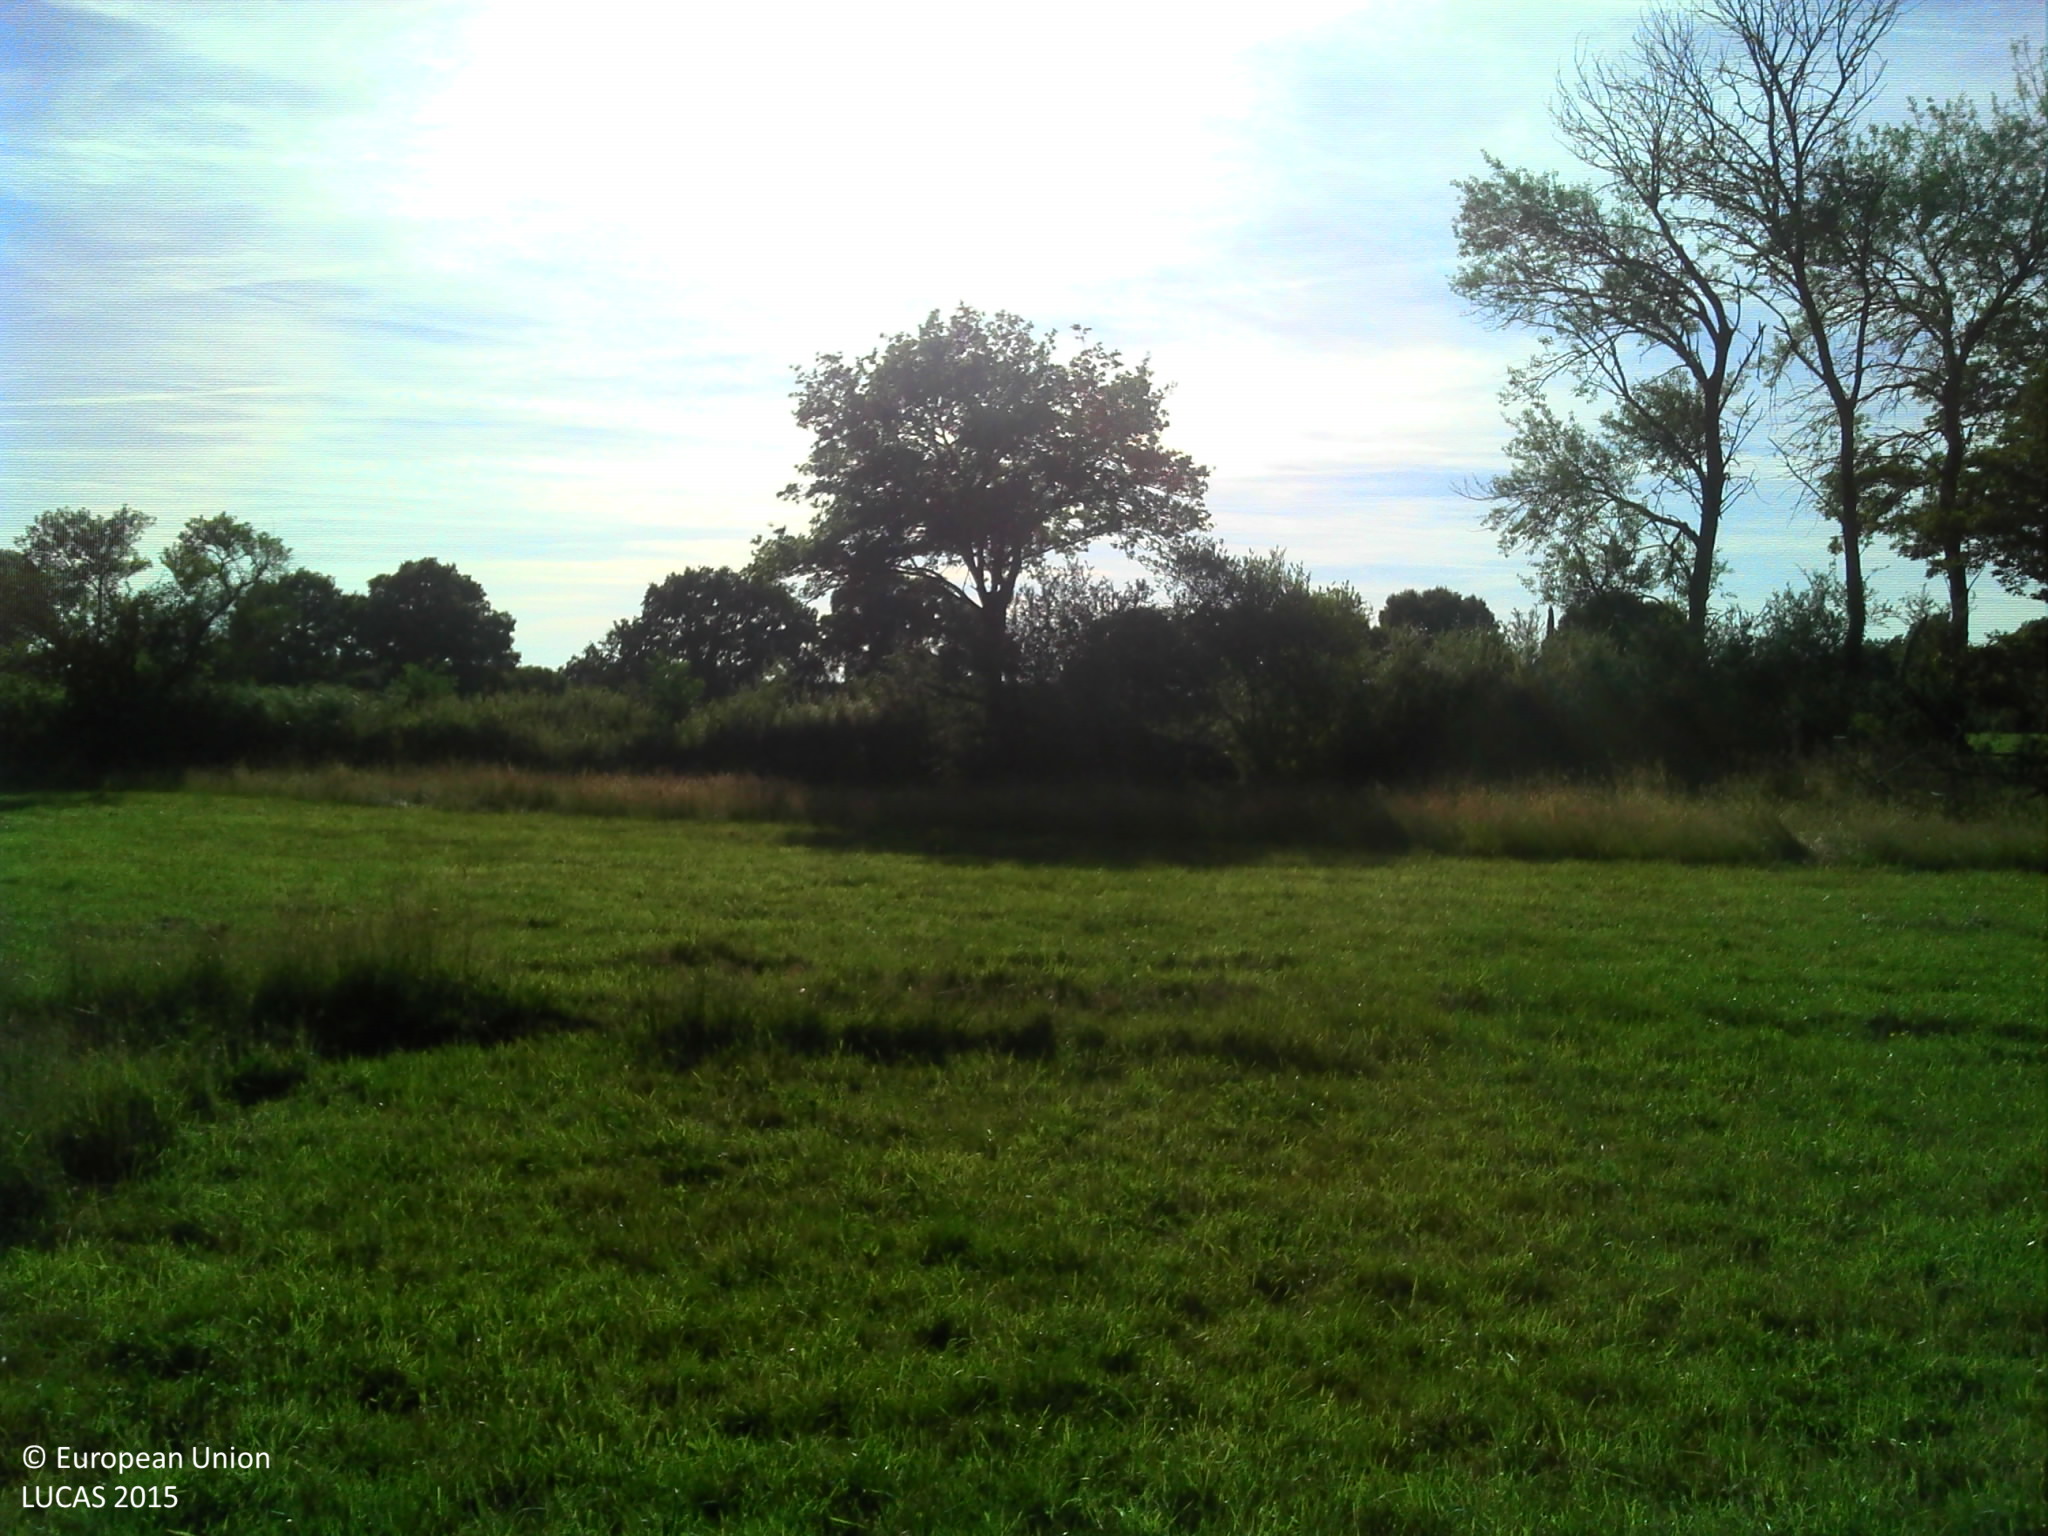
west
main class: Grassland
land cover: Grassland without tree/shrub cover
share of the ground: > 75 %
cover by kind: herbaceous plants 100 %
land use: Agriculture (excluding fallow land and kitchen gardens)
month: June
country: FR
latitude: 46.8238
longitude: 2.9569
